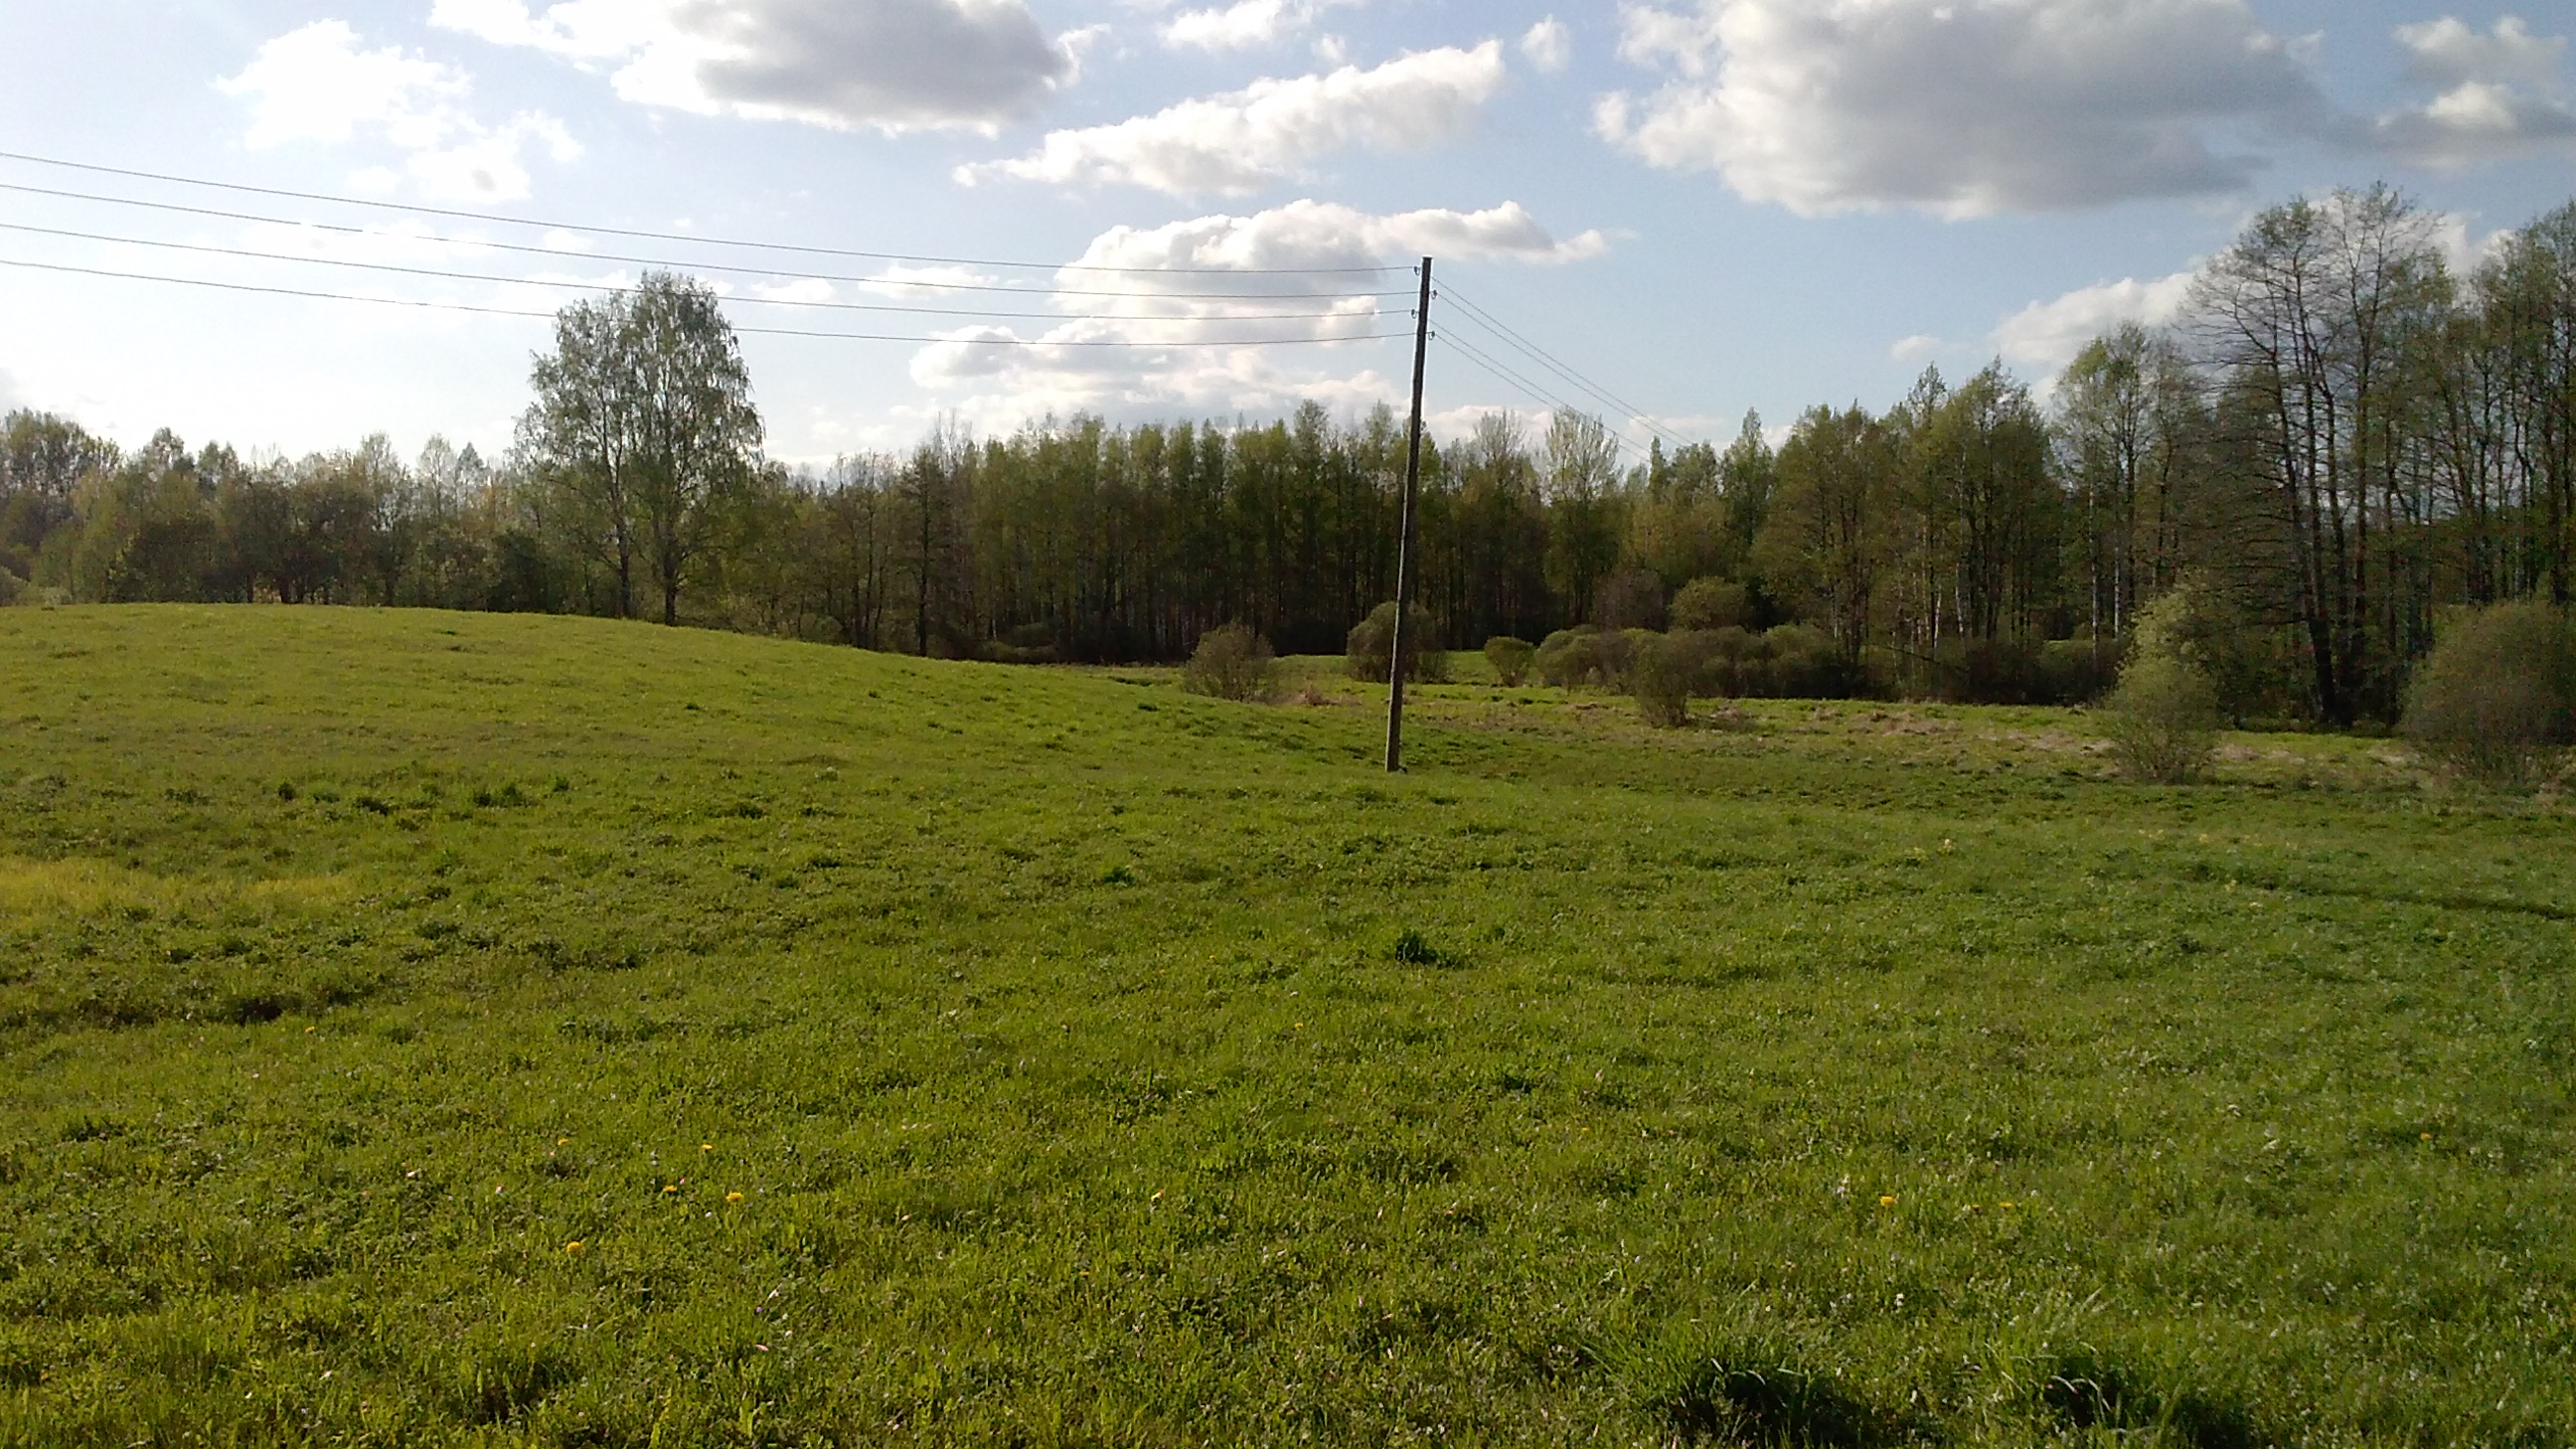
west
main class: Grassland
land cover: Grassland without tree/shrub cover
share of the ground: > 75 %
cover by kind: herbaceous plants 100 %
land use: Agriculture (excluding fallow land and kitchen gardens)
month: May
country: LV
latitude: 56.0579
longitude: 27.2434
